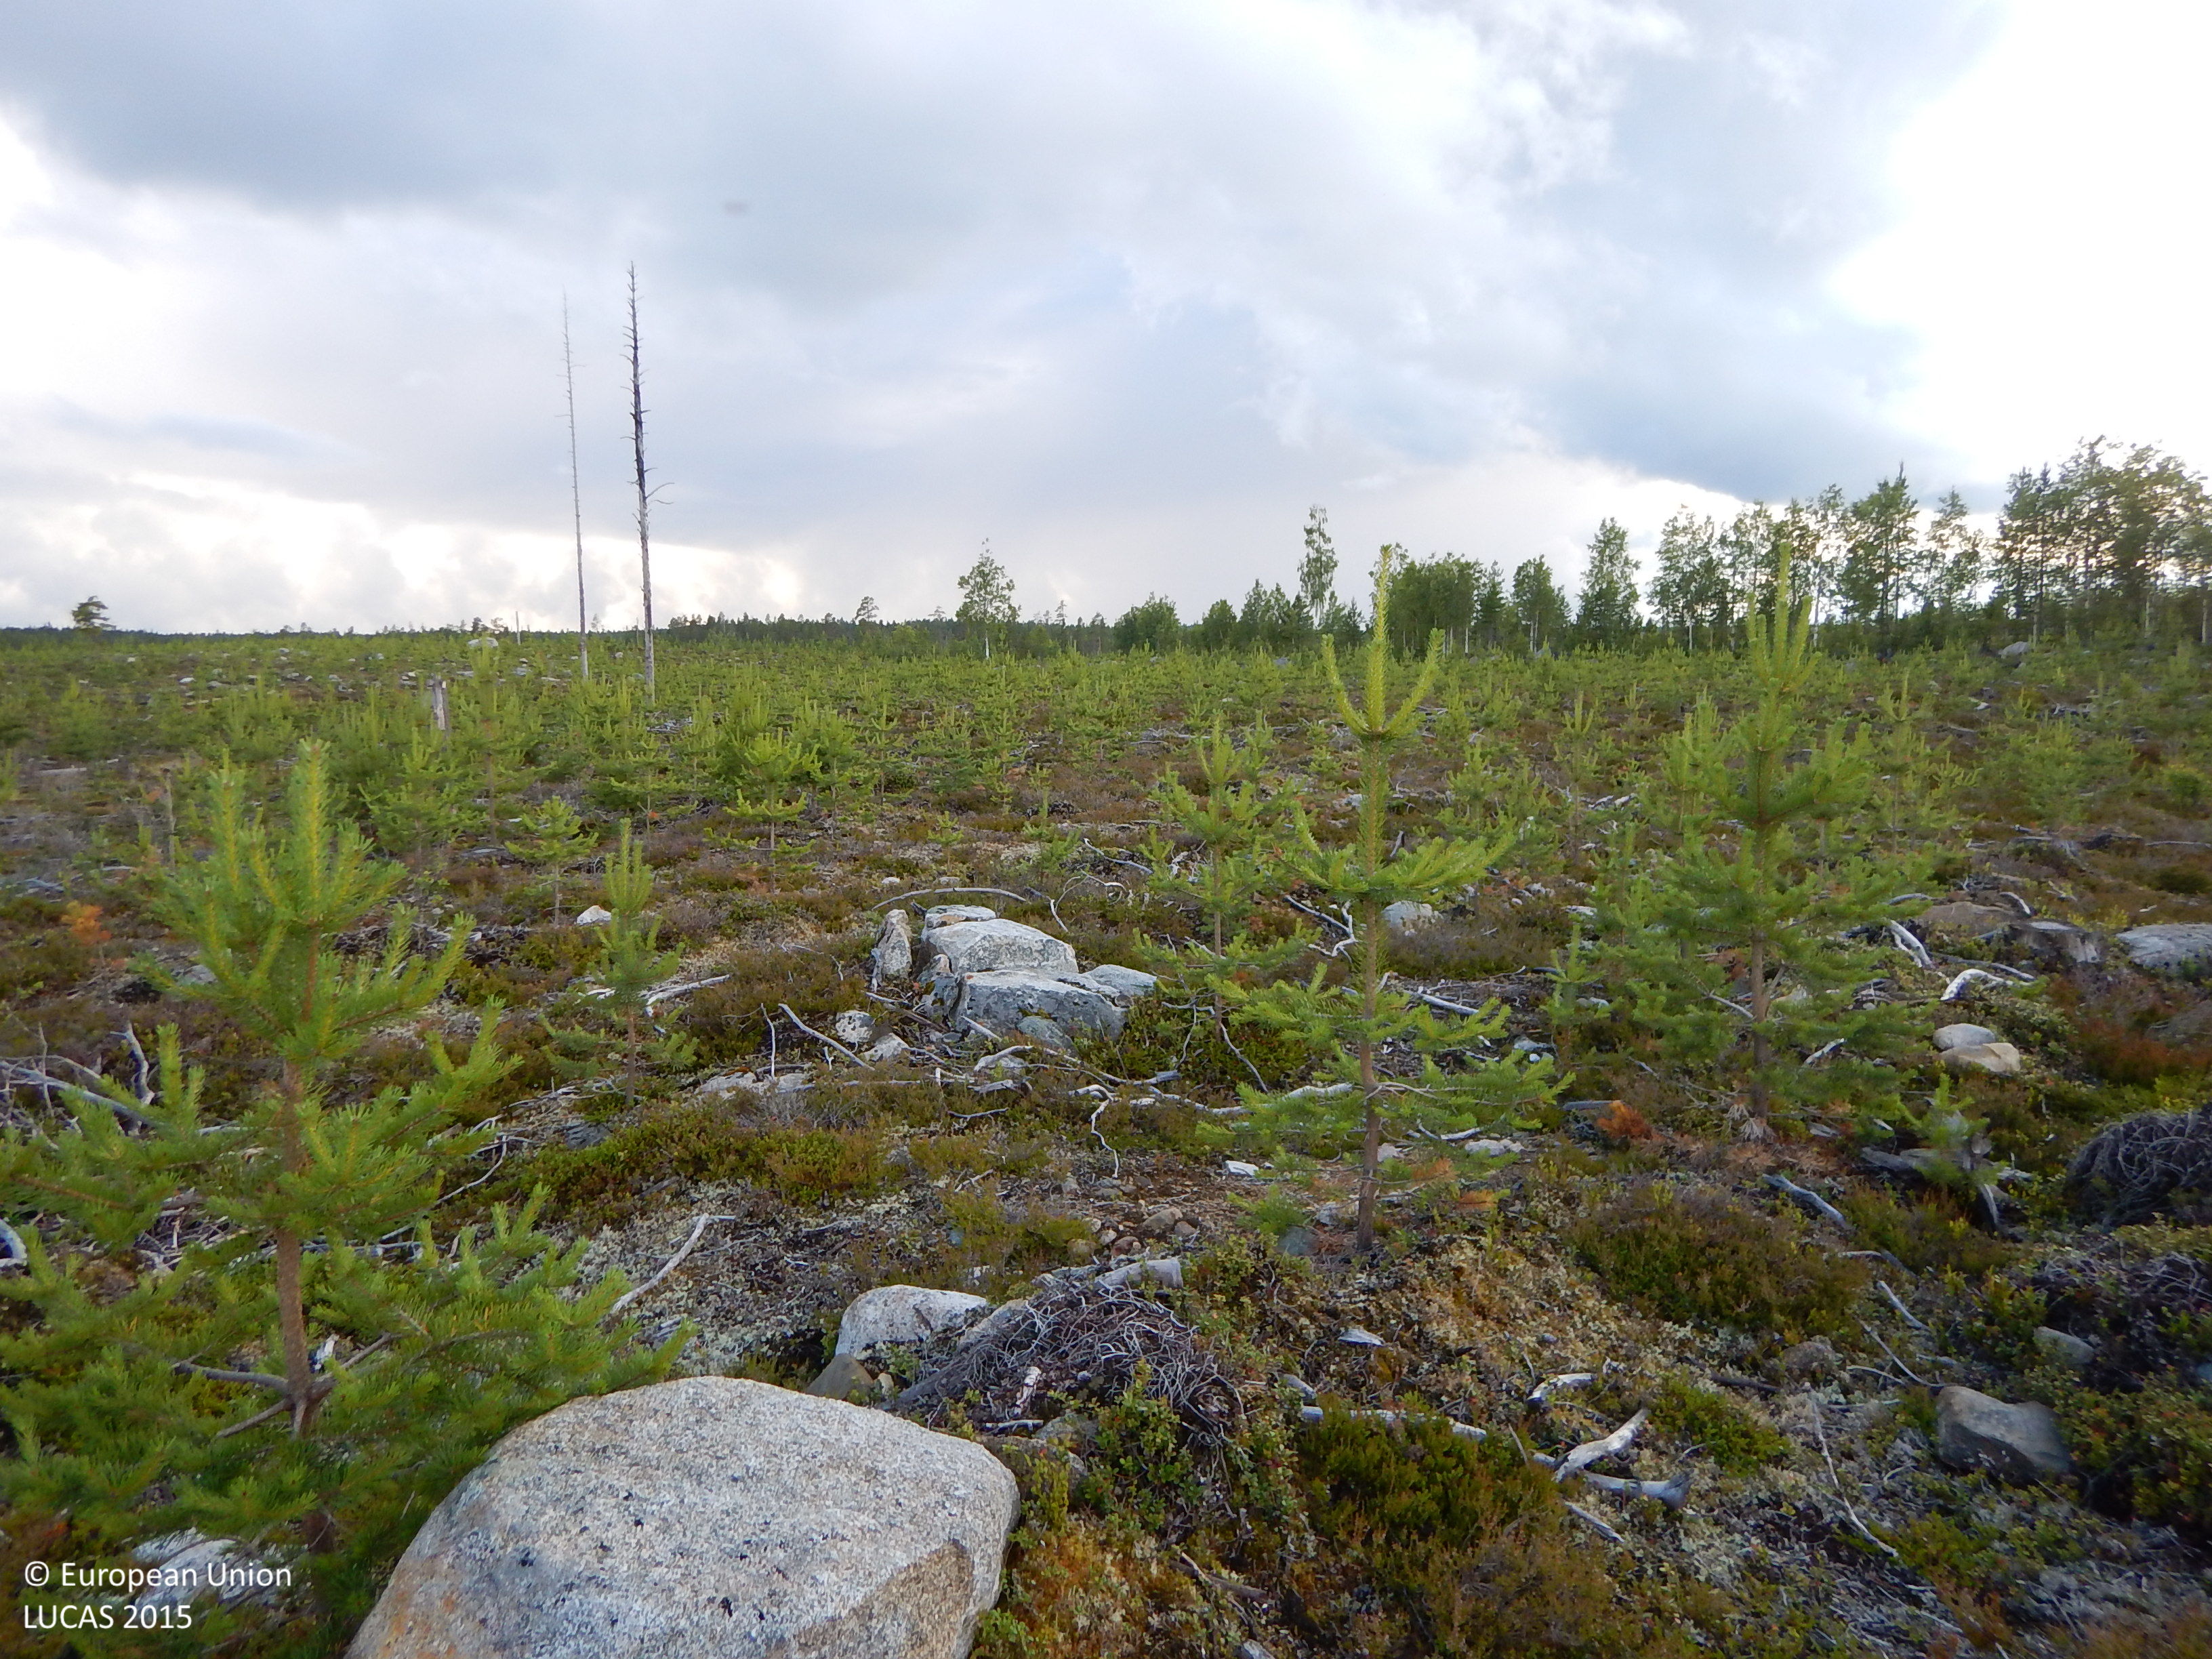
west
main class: Woodland
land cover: Pine dominated coniferous woodland
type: boreal forest
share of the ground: 10 - 25 %
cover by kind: lichens and mosses 30 %, shrubs 20 %, unconsolidated bare surface 20 %, coniferous forest trees 10 %, herbaceous plants 10 %, consolidated bare surface 10 %
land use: Forestry
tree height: < 5 m
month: July
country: SE
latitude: 64.7768
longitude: 20.2573
